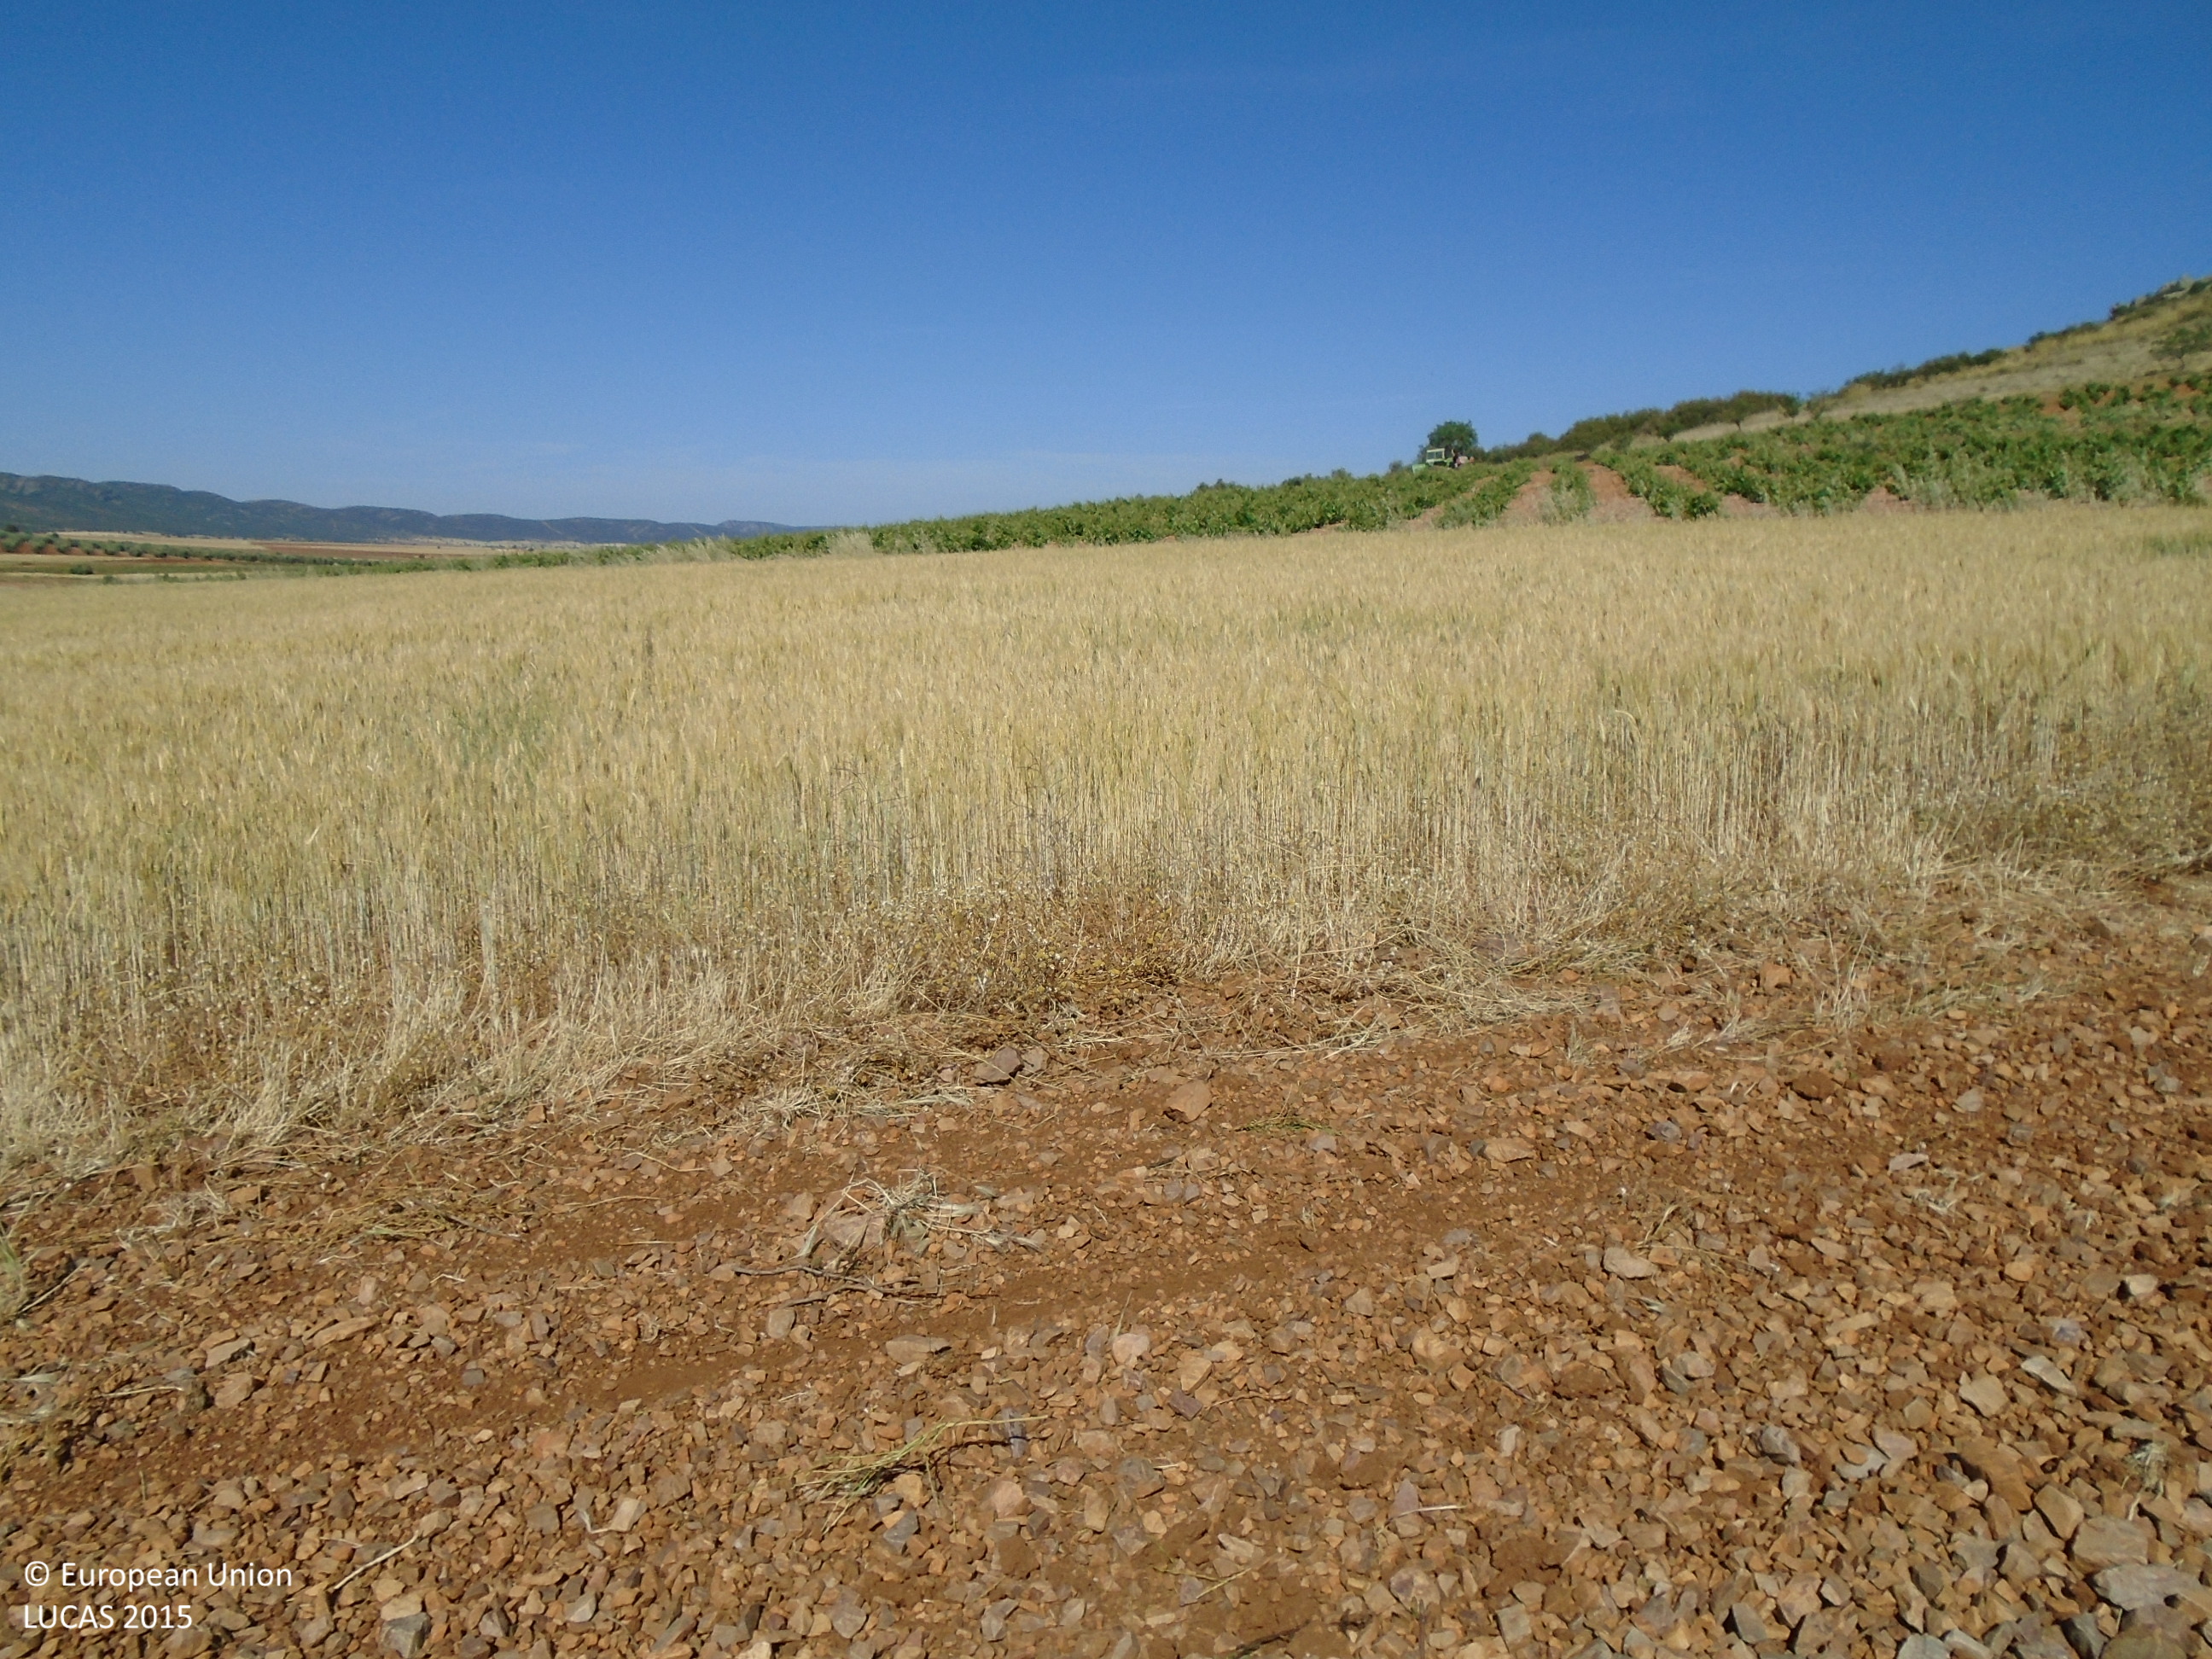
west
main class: Cropland
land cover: Vineyards
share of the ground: > 75 %
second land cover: Other bare soil
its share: > 75 %
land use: Agriculture (excluding fallow land and kitchen gardens)
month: May
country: ES
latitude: 39.4897
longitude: -3.6632
